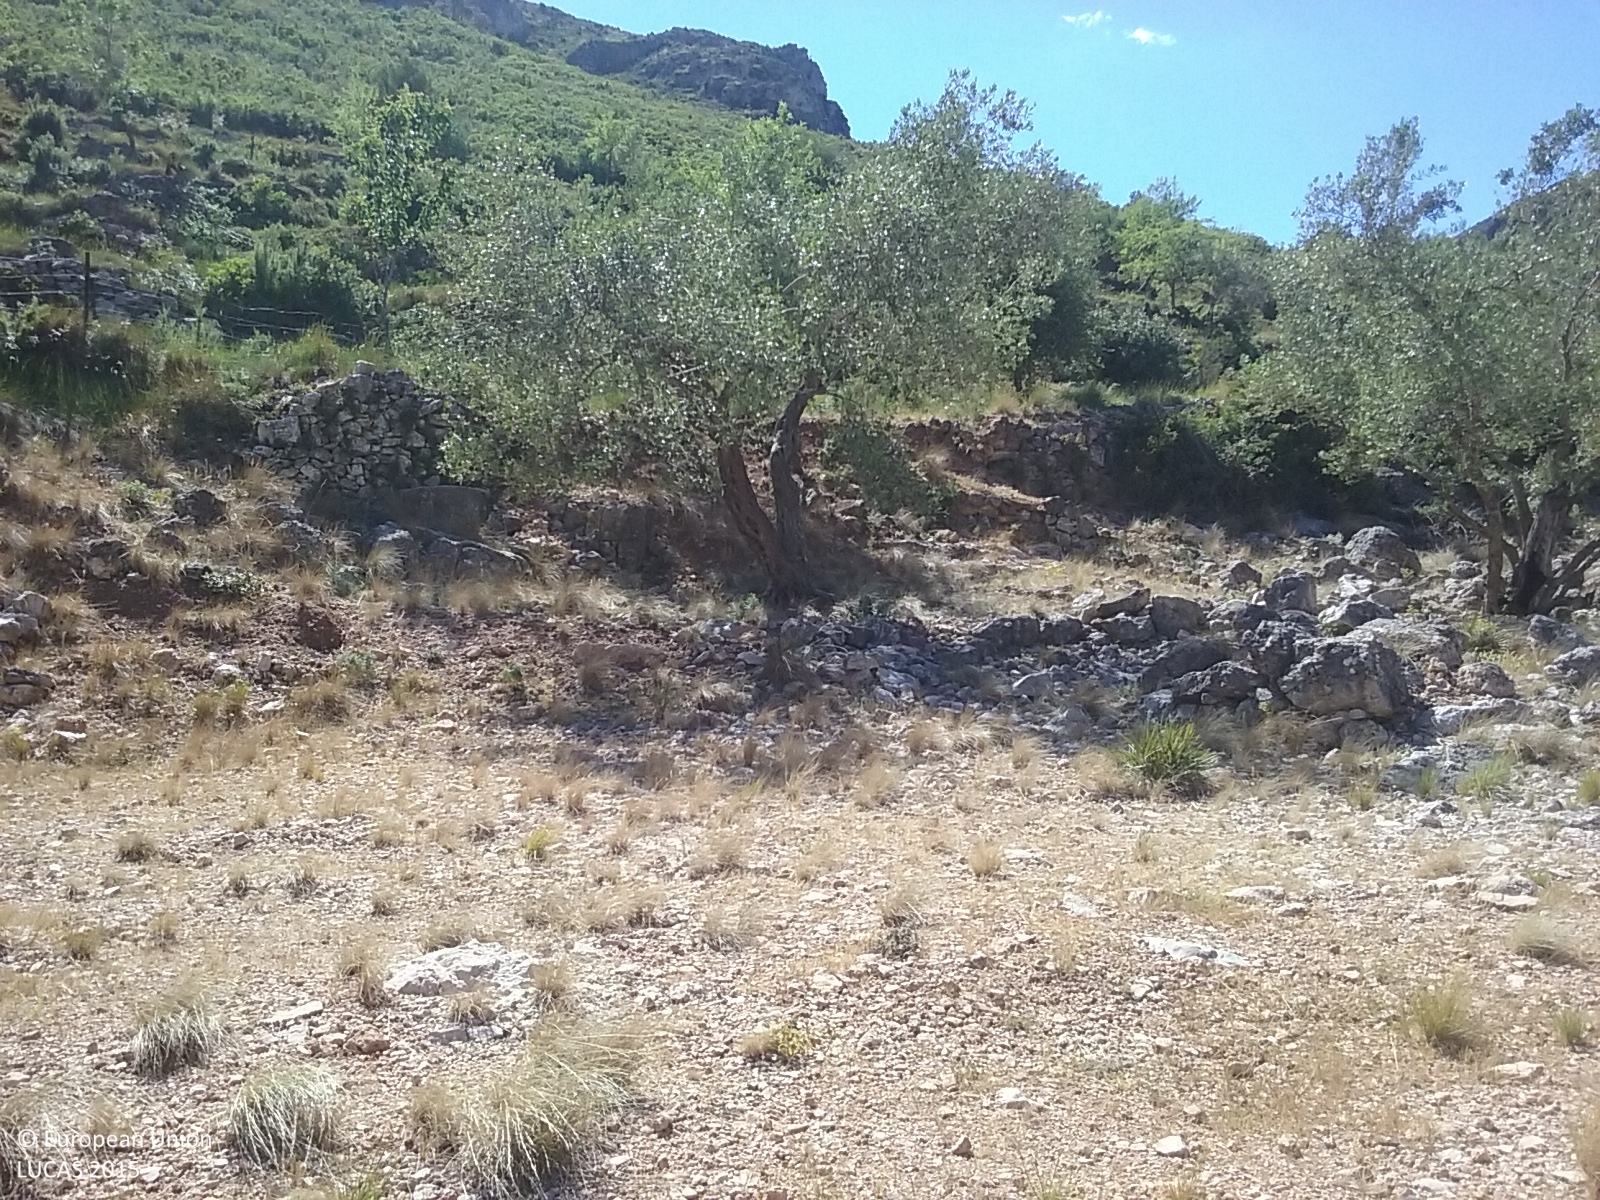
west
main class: Cropland
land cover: Olive groves
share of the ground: 25 - 50 %
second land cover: Other bare soil
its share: > 75 %
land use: Agriculture (excluding fallow land and kitchen gardens)
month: May
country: ES
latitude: 40.7770
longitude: 0.3843
